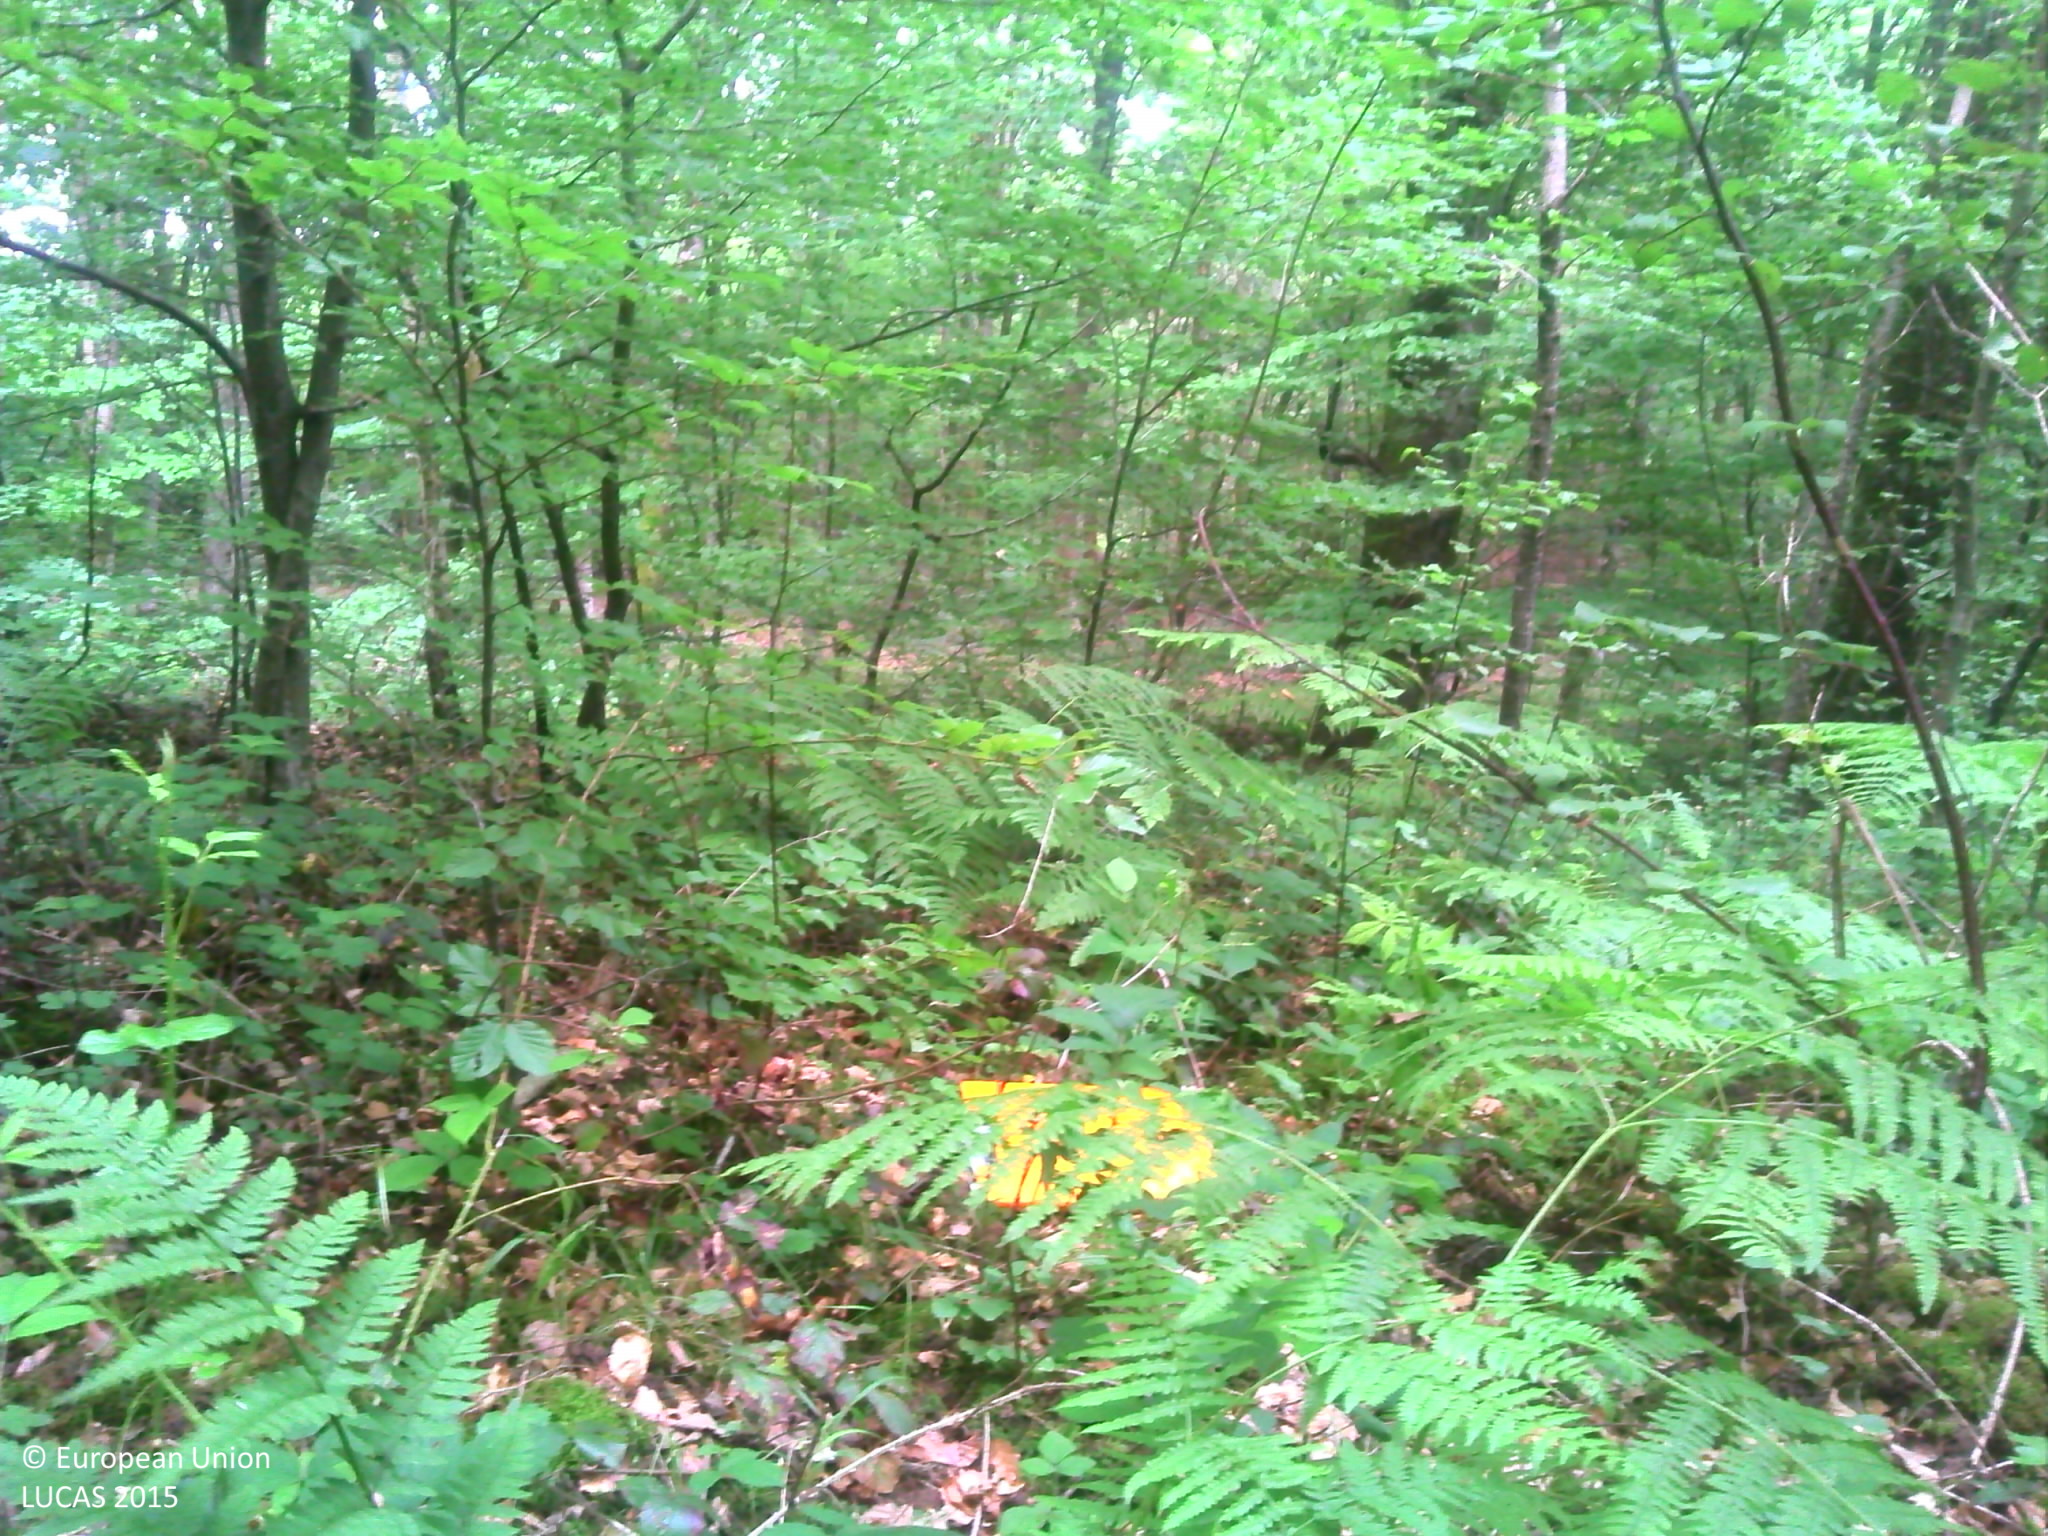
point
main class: Woodland
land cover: Broadleaved woodland
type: beech forest
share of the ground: > 75 %
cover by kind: broadleaved forest trees 90 %, herbaceous plants 10 %
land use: Forestry
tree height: > 5 m
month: June
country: FR
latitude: 47.8390
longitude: 6.3535
